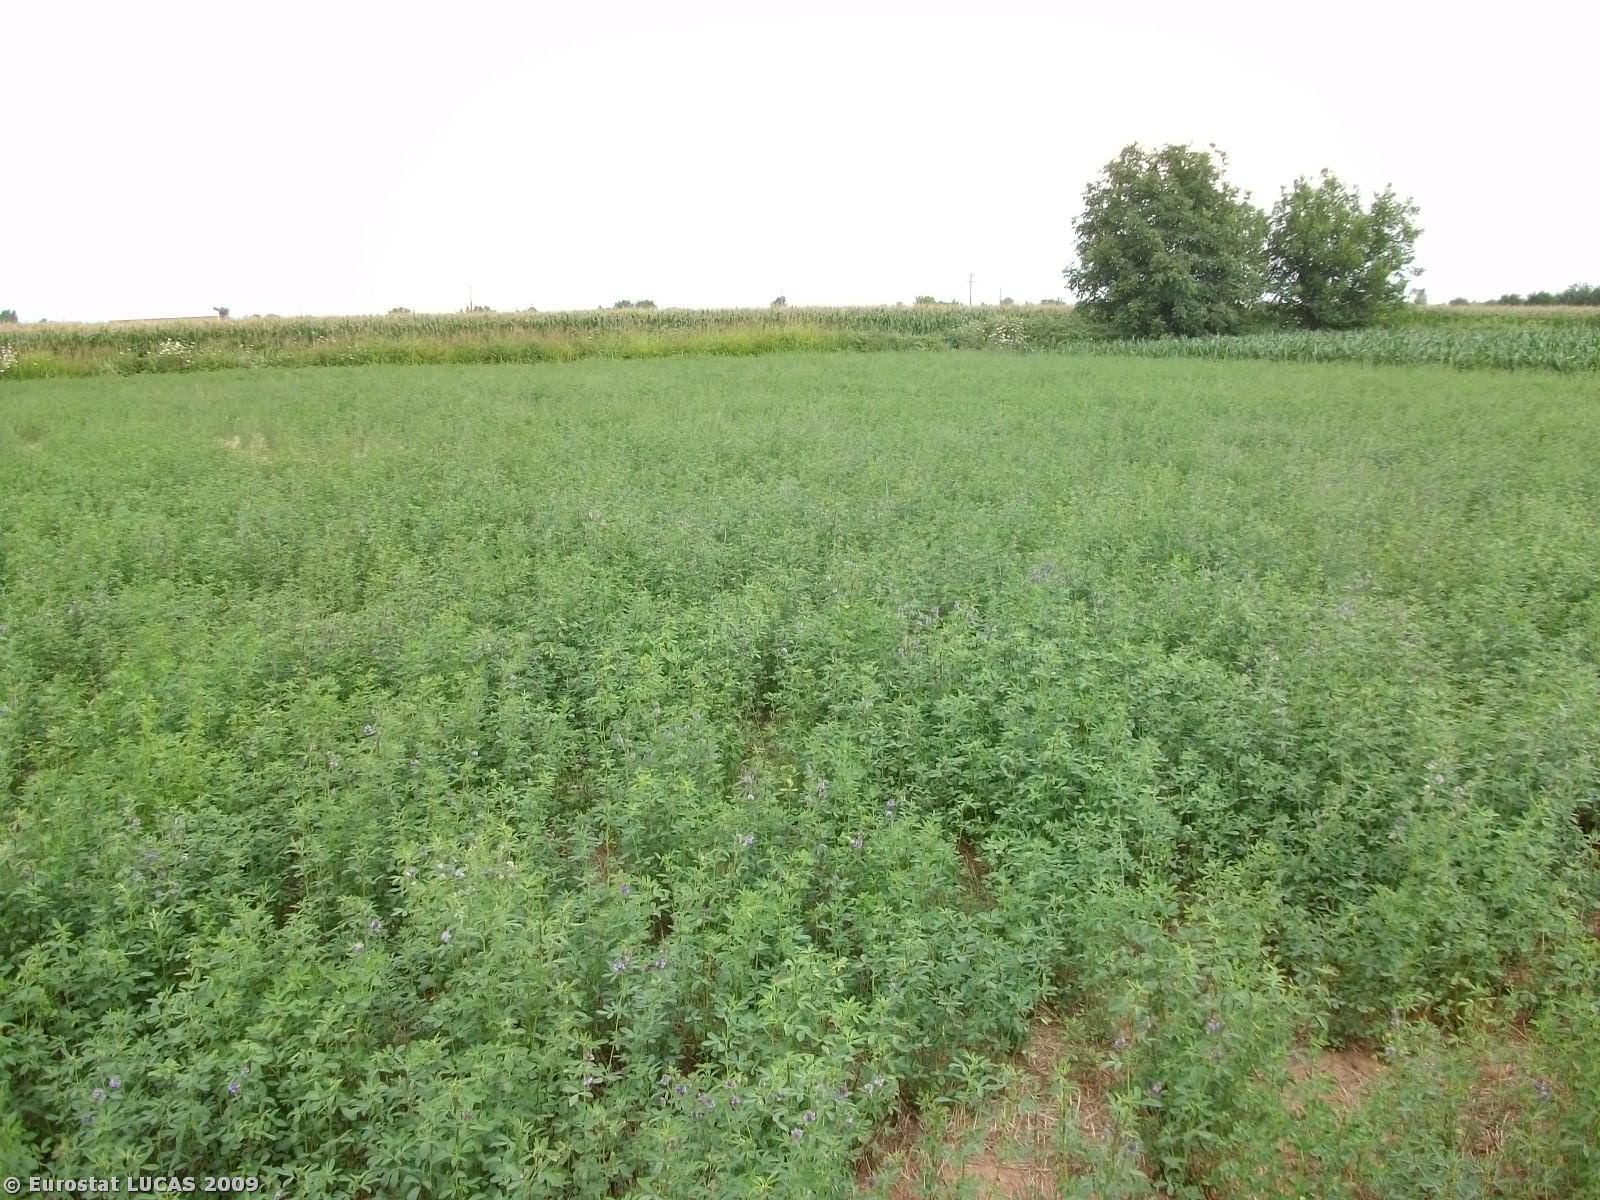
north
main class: Cropland
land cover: Clovers
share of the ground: > 75 %
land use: Agriculture (excluding fallow land and kitchen gardens)
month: July
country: GR
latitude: 39.4927
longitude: 21.6912
